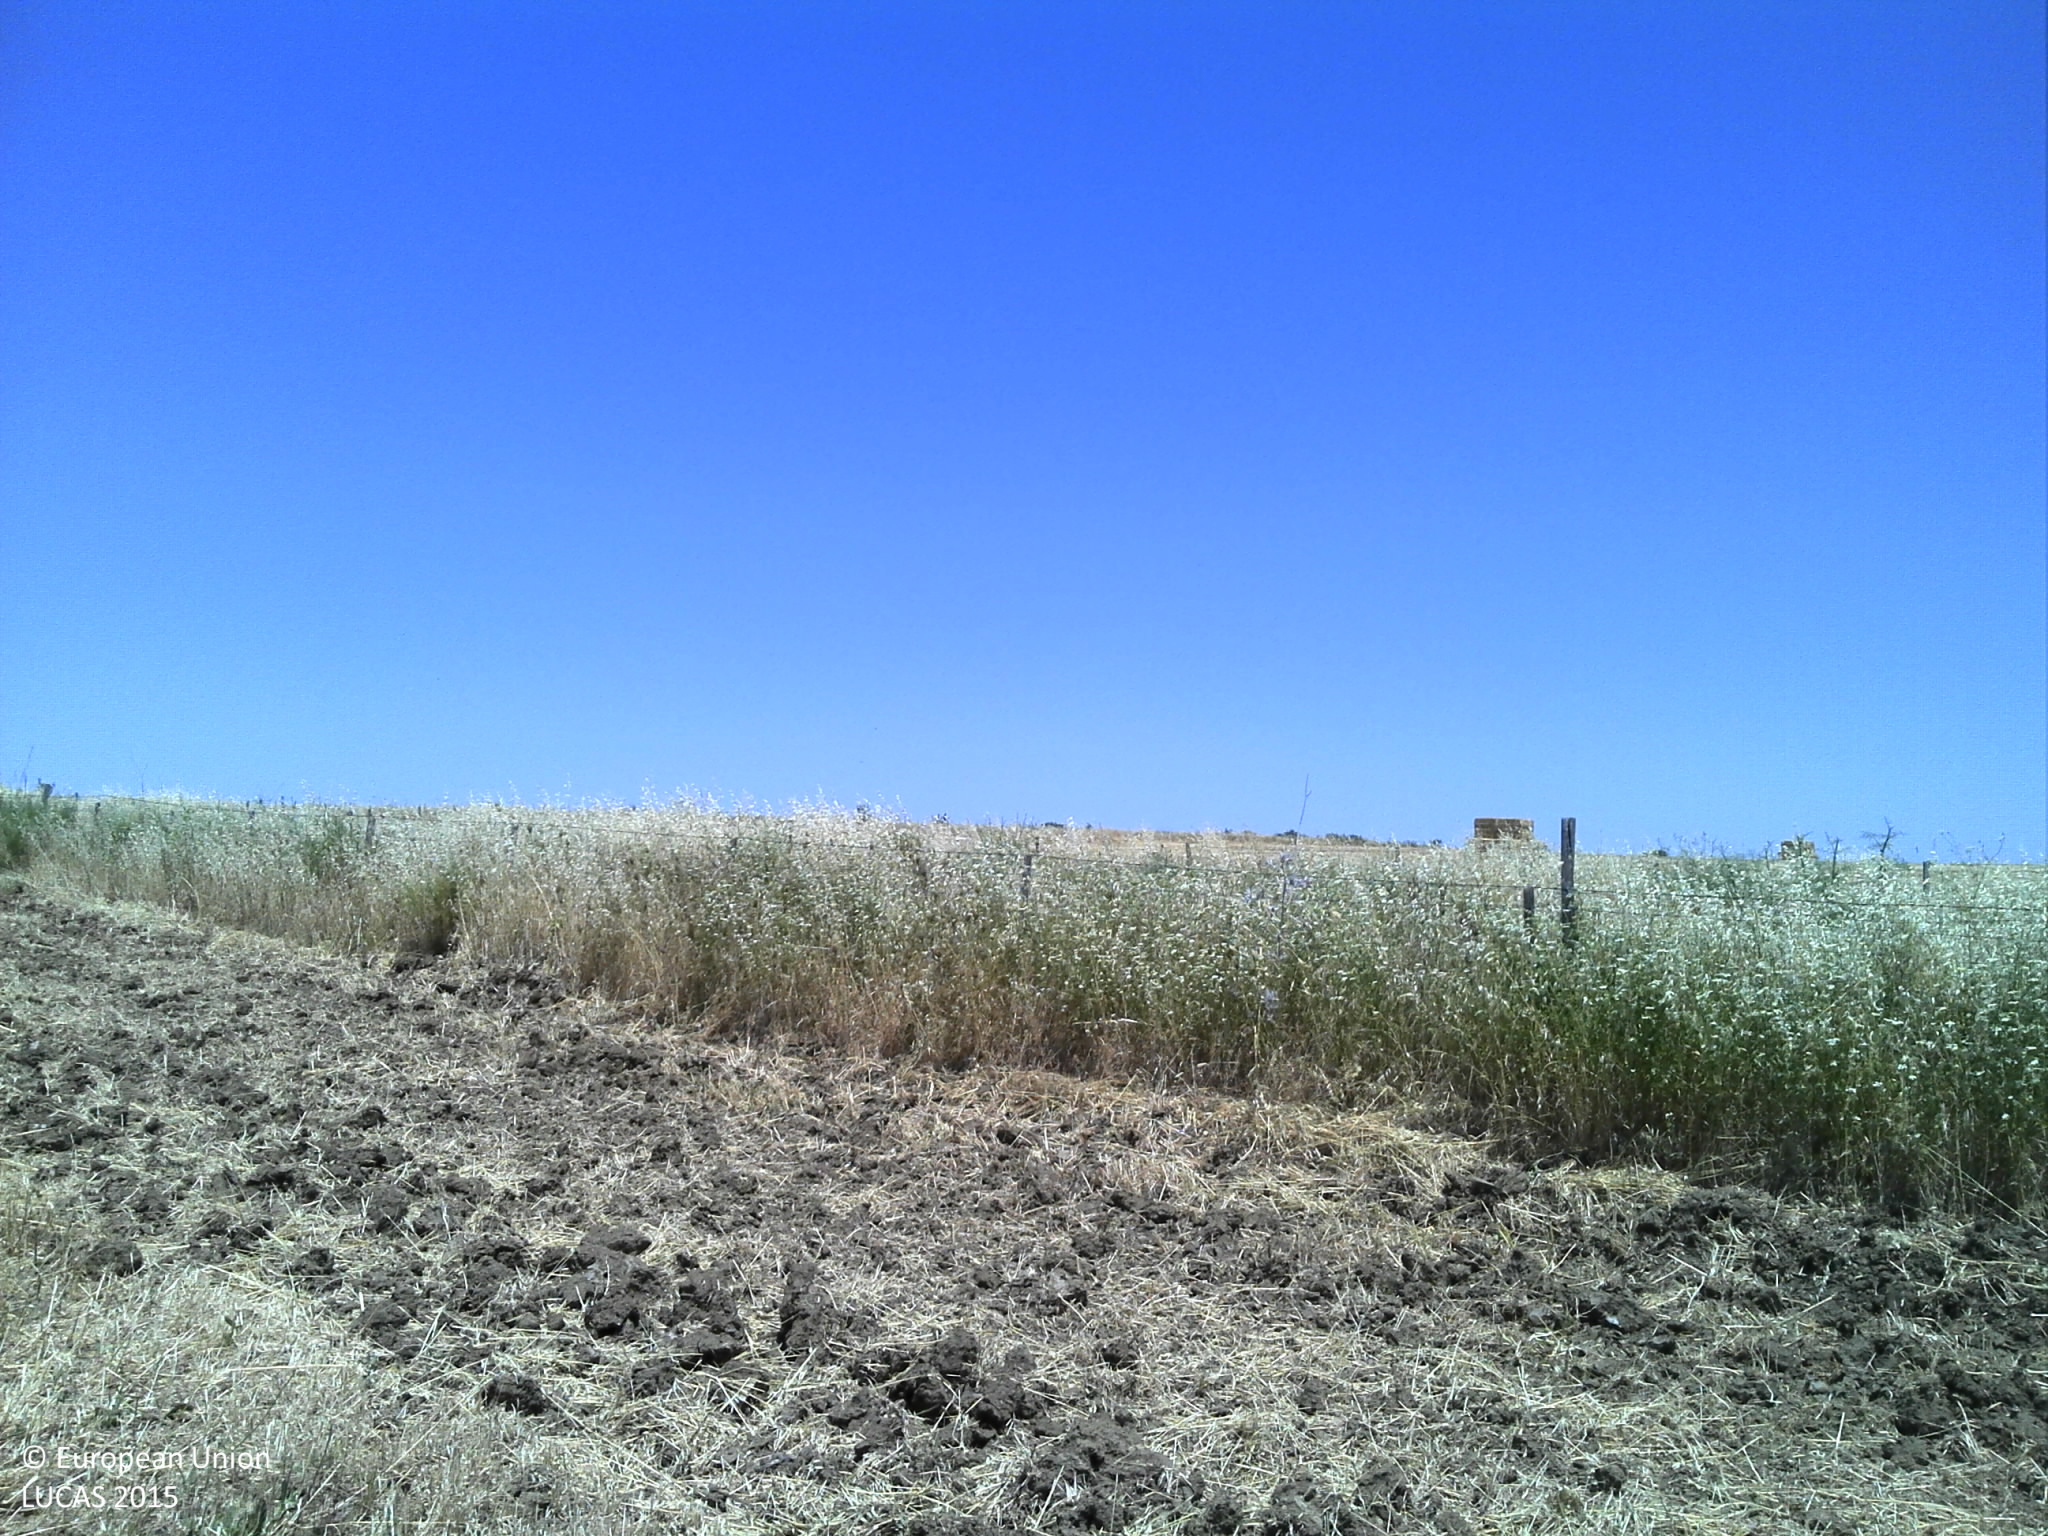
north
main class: Cropland
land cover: Oats
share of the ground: 10 - 25 %
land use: Agriculture (excluding fallow land and kitchen gardens)
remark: Harvested field
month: May
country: PT
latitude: 38.9943
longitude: -7.6012
